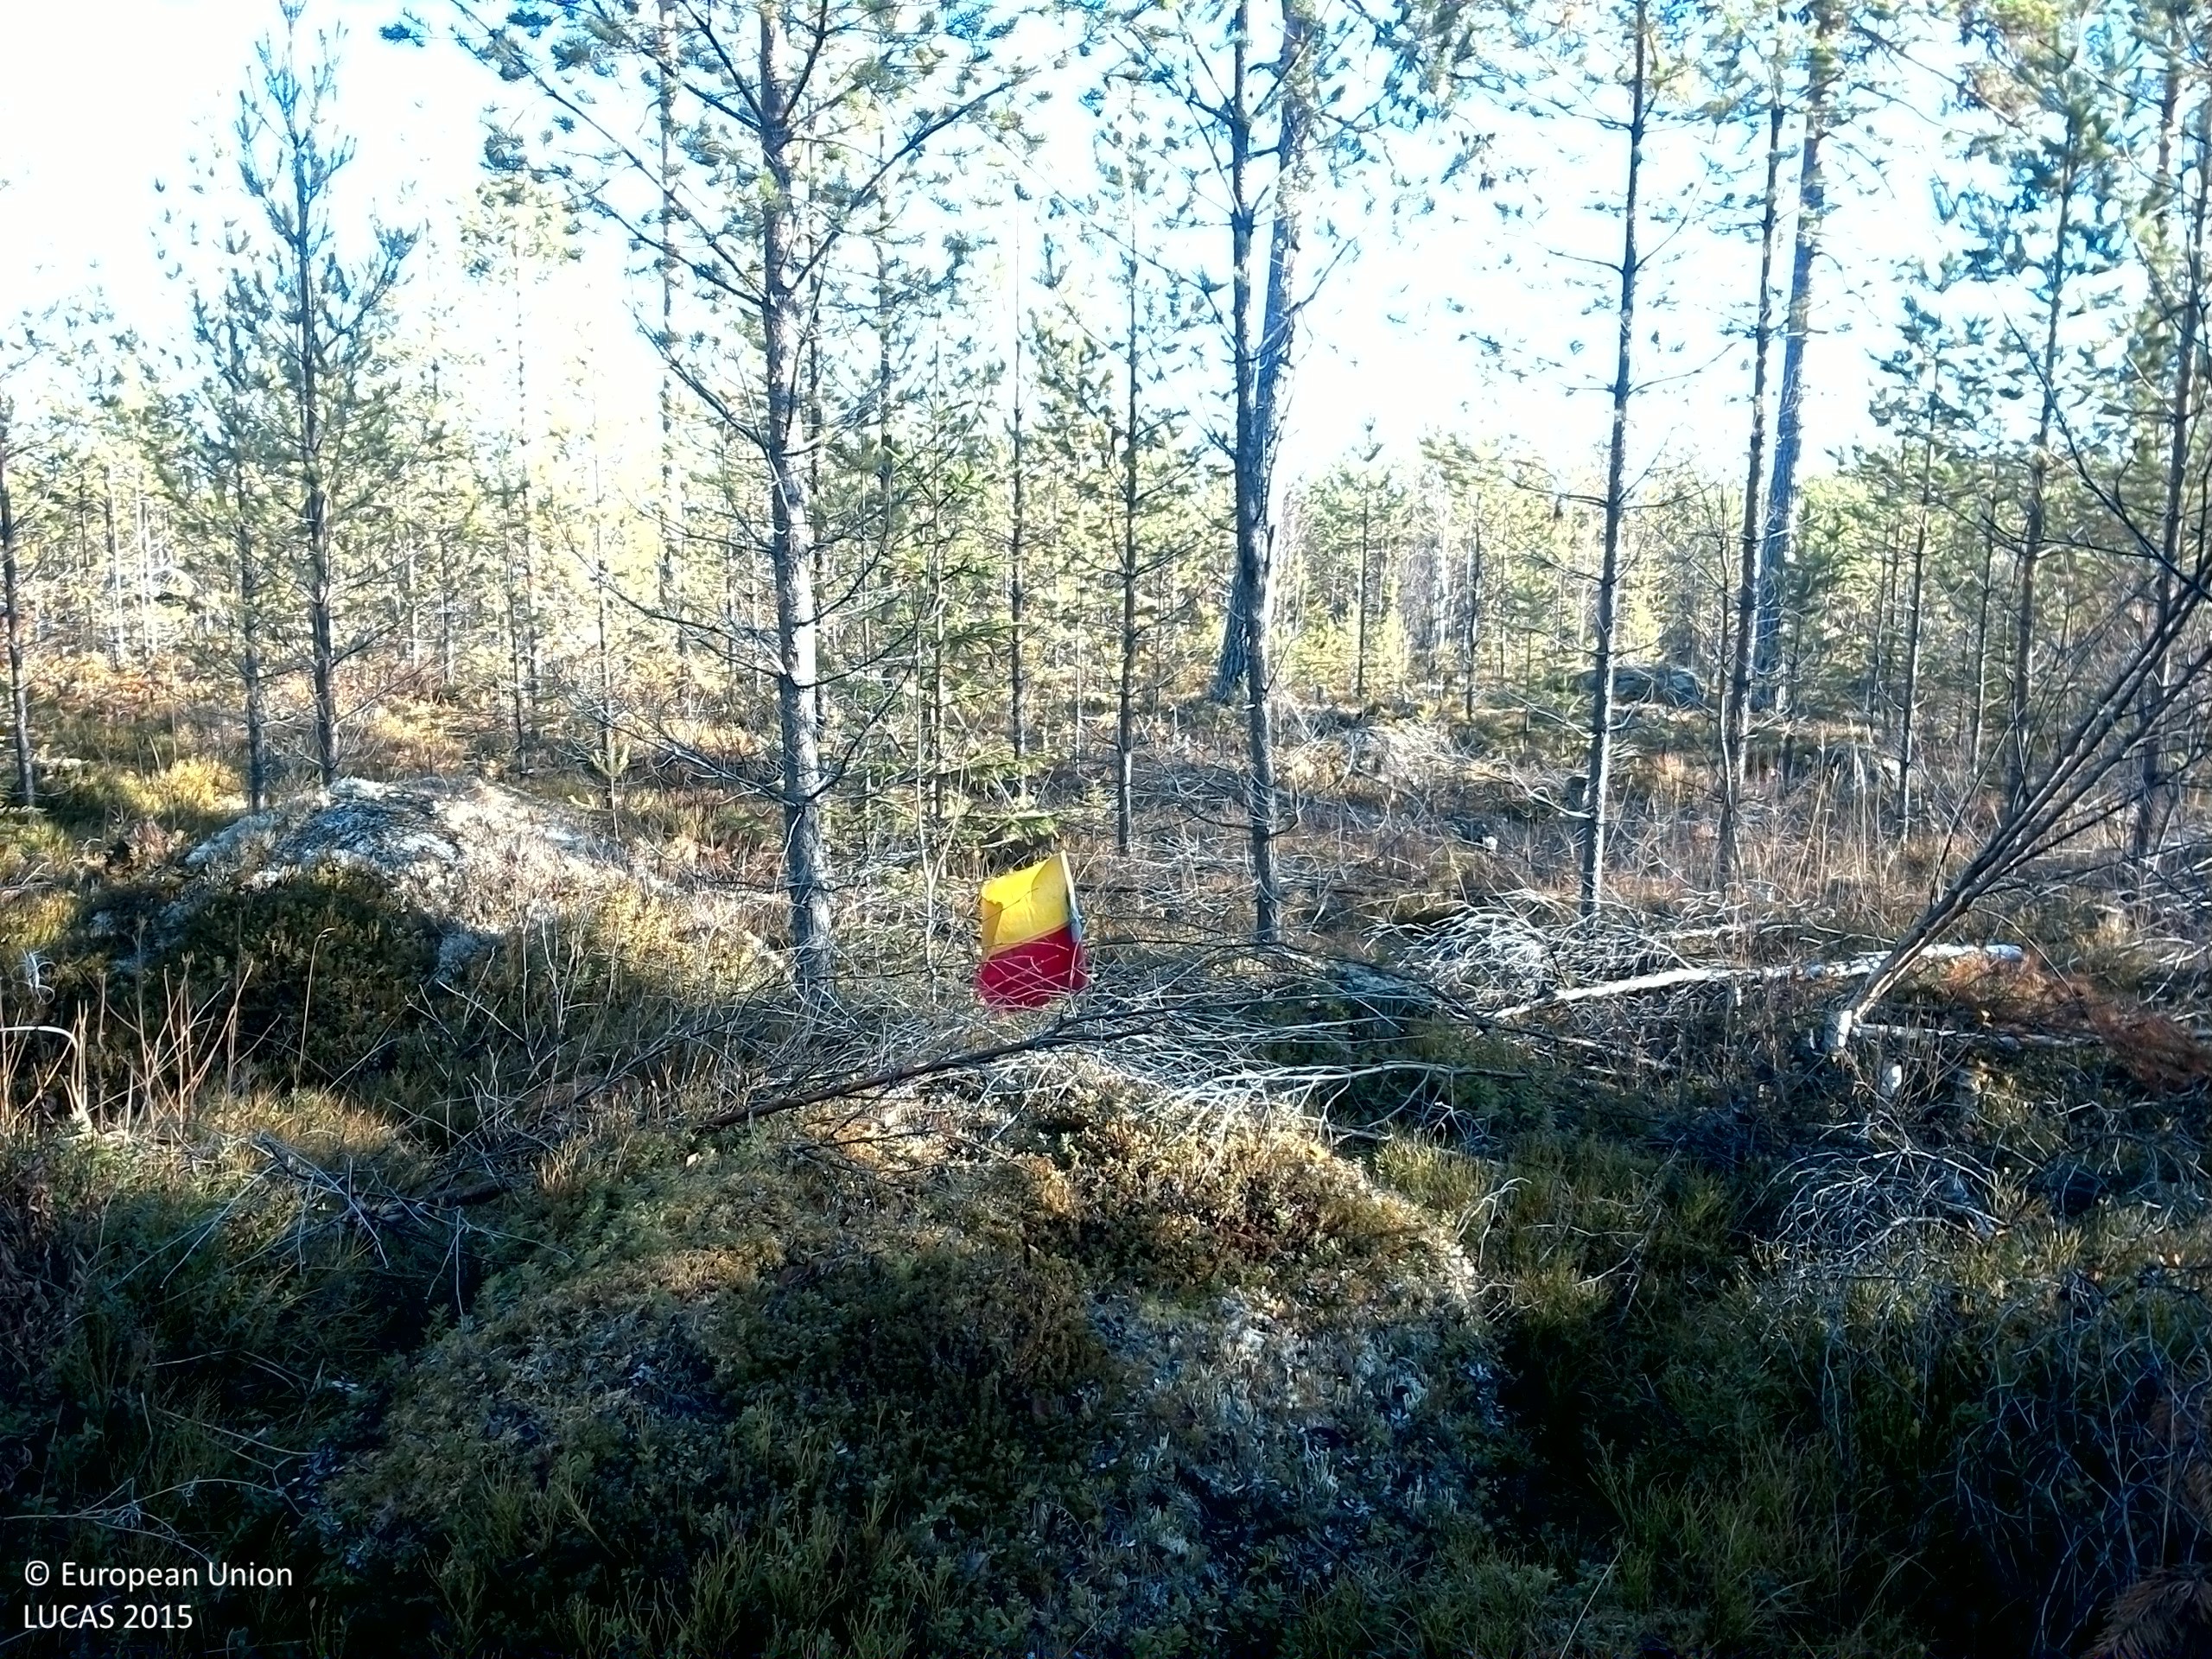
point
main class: Woodland
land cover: Pine dominated coniferous woodland
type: boreal forest
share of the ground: 25 - 50 %
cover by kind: shrubs 40 %, coniferous forest trees 35 %, lichens and mosses 20 %, broadleaved forest trees 5 %
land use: Forestry
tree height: < 5 m
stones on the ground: > 50 %
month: October
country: SE
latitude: 63.7433
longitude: 15.9498
